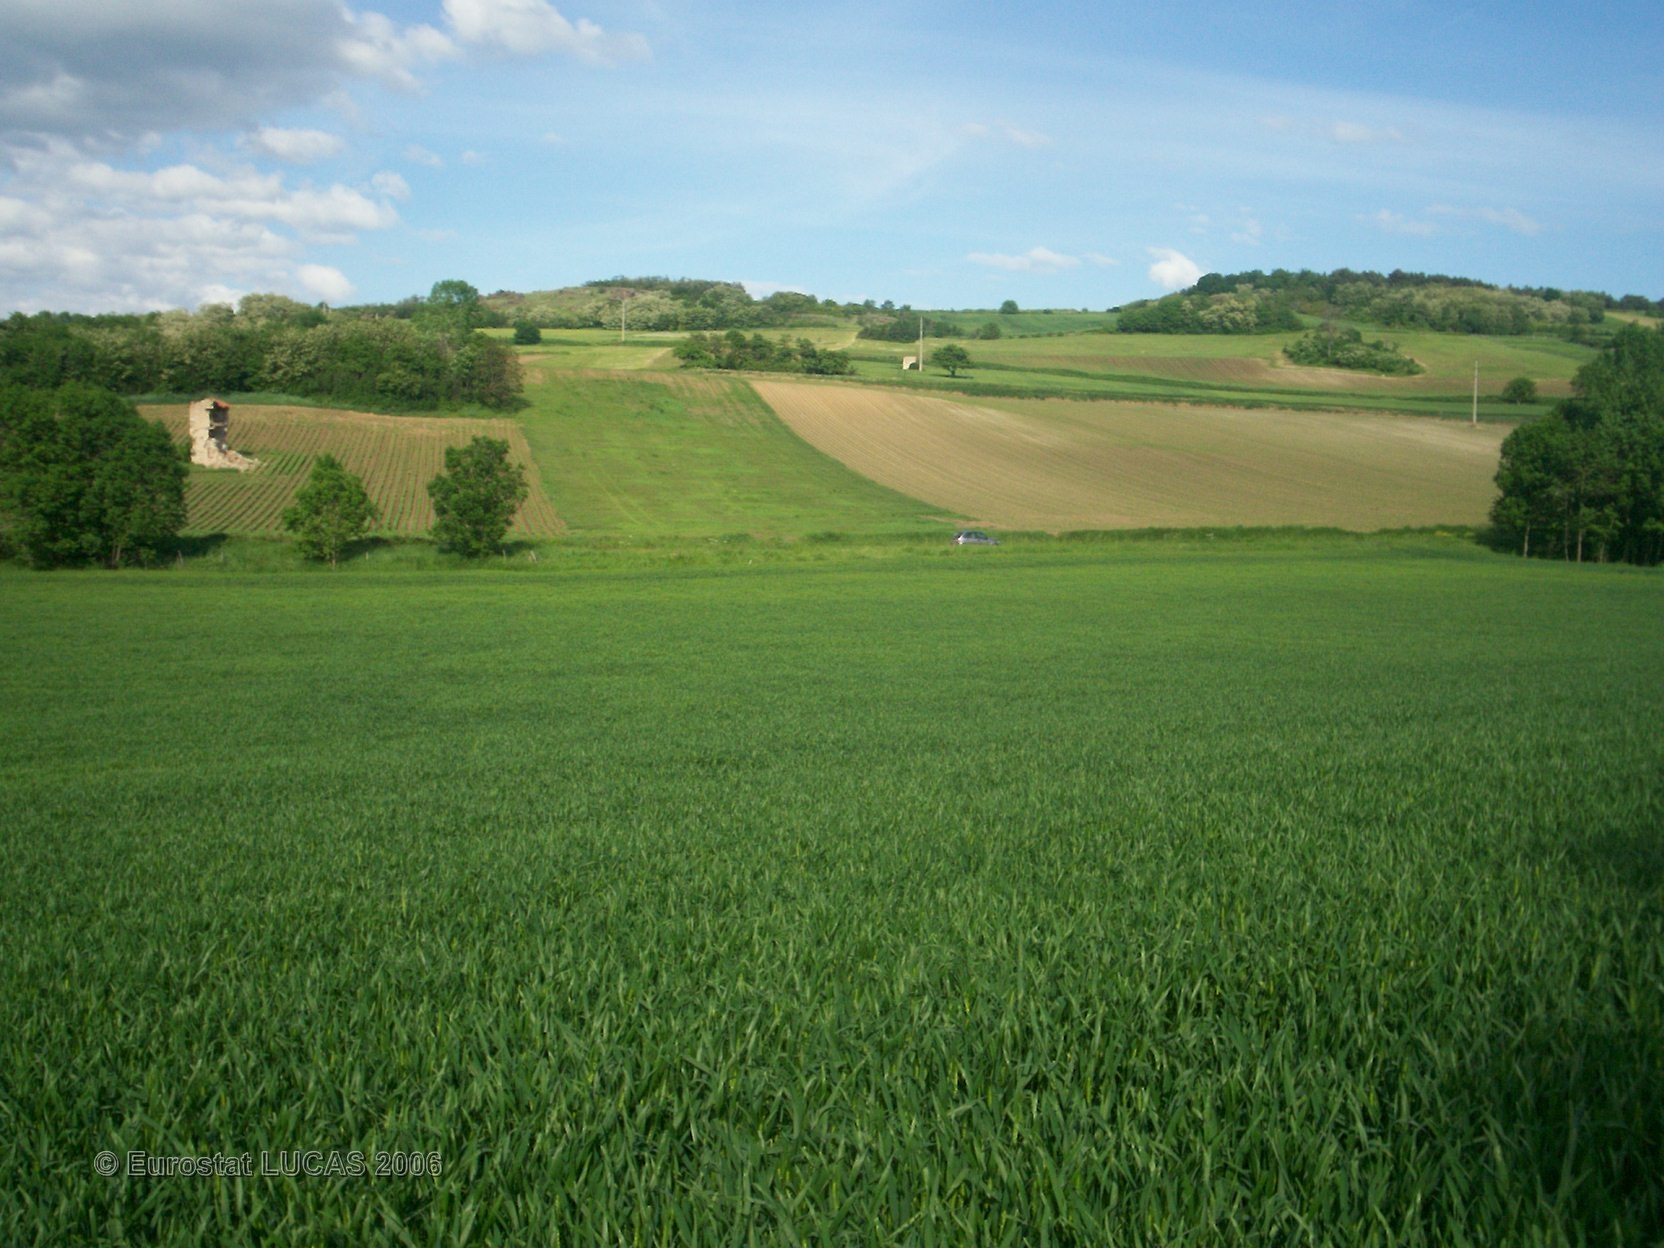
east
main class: Cropland
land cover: Triticale
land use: Agriculture (excluding fallow land and kitchen gardens)
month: May
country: FR
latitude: 45.7600
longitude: 3.2762
